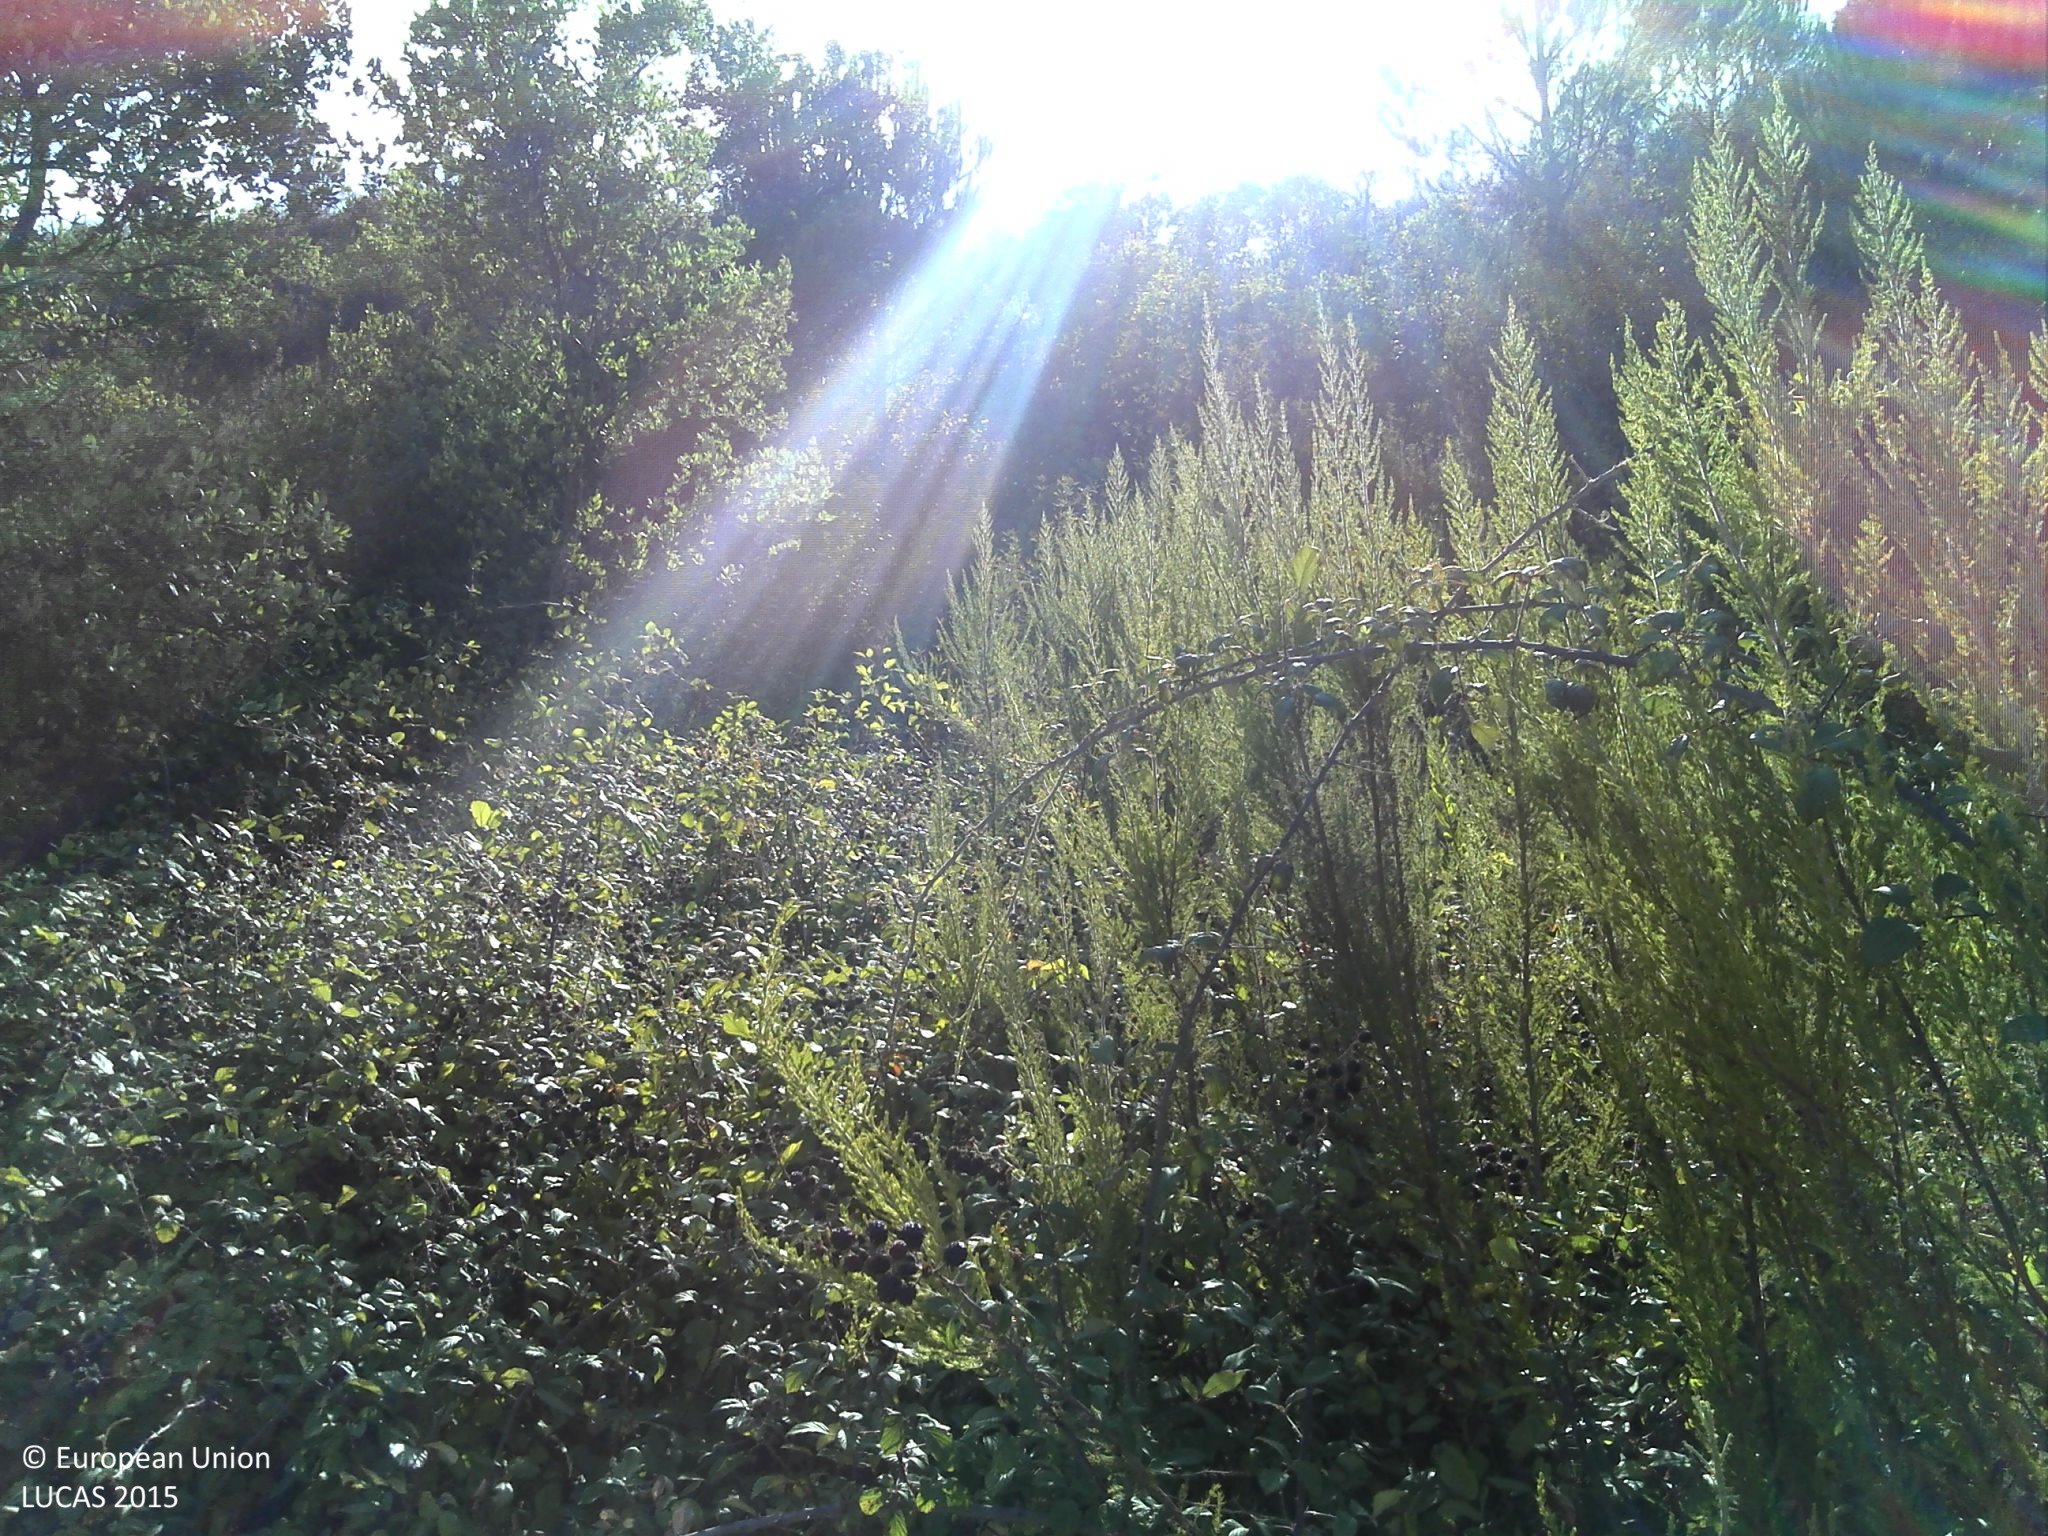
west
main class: Shrubland
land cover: Shrubland with sparse tree cover
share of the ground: 50 - 75 %
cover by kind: shrubs 70 %, unconsolidated bare surface 25 %, broadleaved forest trees 5 %
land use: Forestry
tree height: < 5 m
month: September
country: PT
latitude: 37.3892
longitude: -8.4507
